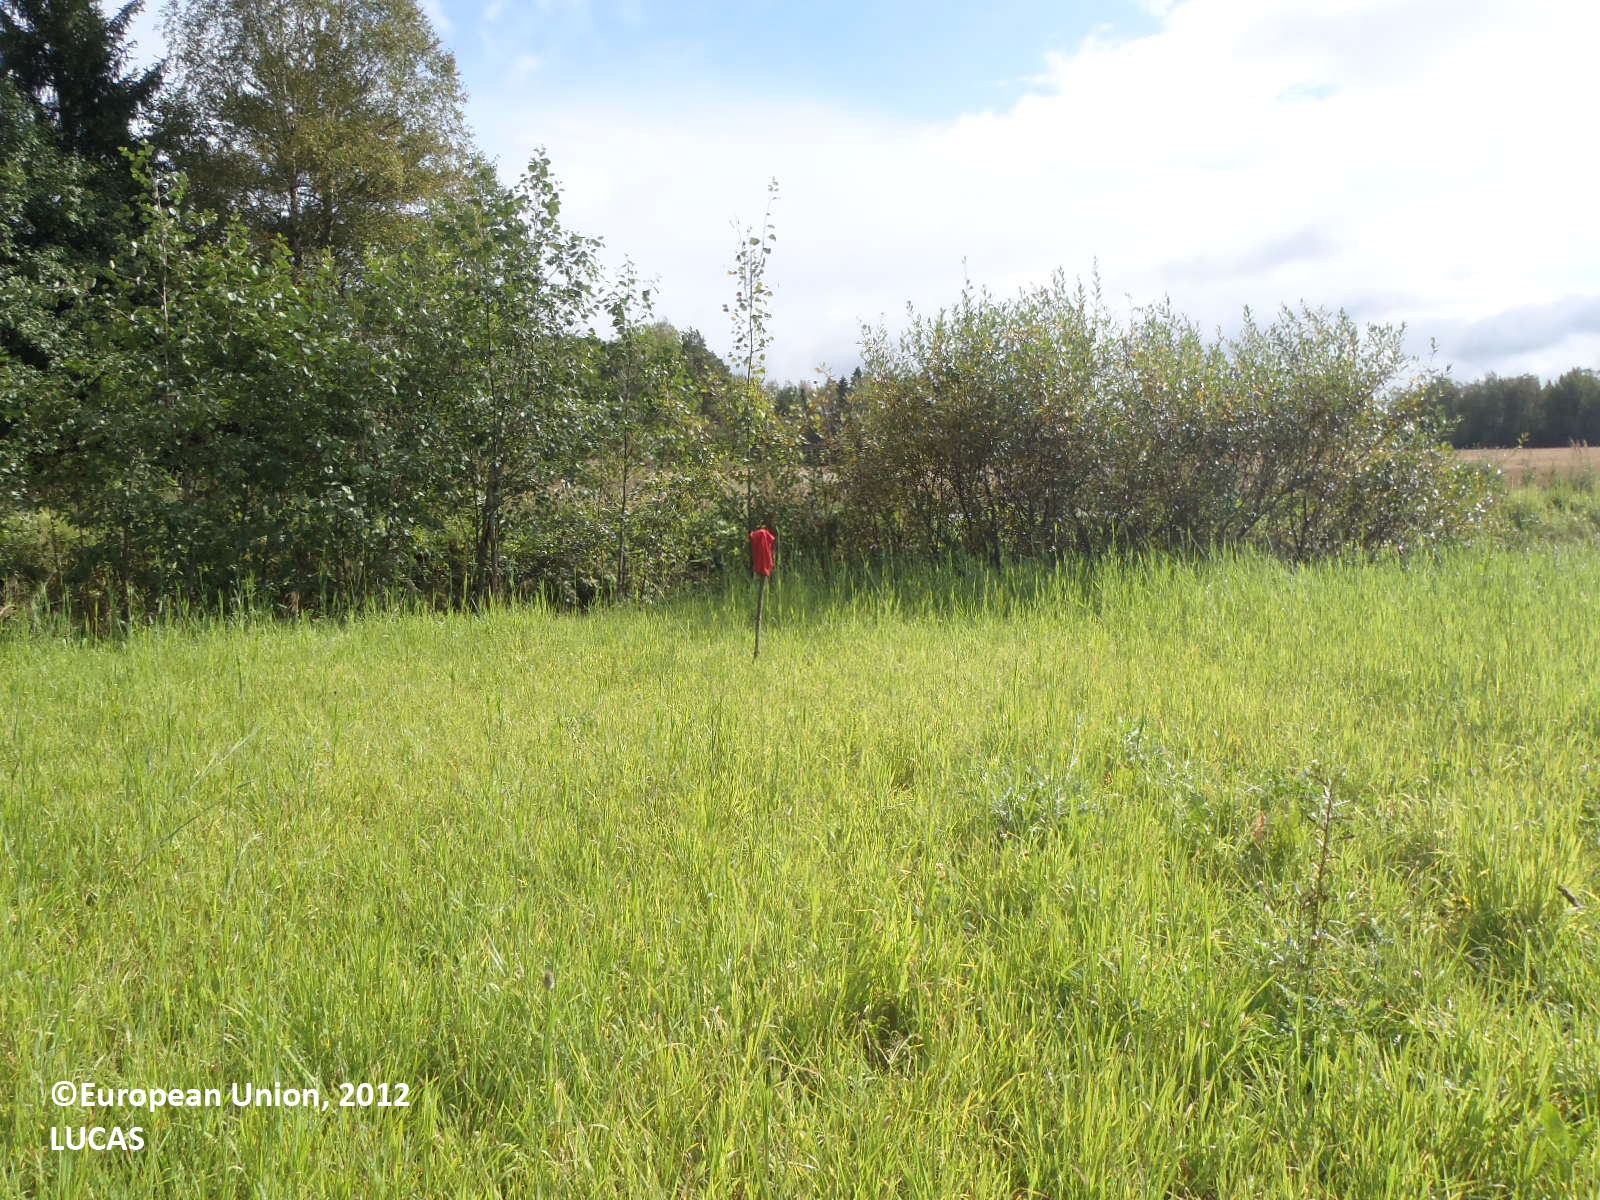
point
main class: Cropland
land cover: Temporary grasslands
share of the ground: > 75 %
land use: Agriculture (excluding fallow land and kitchen gardens)
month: September
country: FI
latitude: 61.0668
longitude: 22.6881
